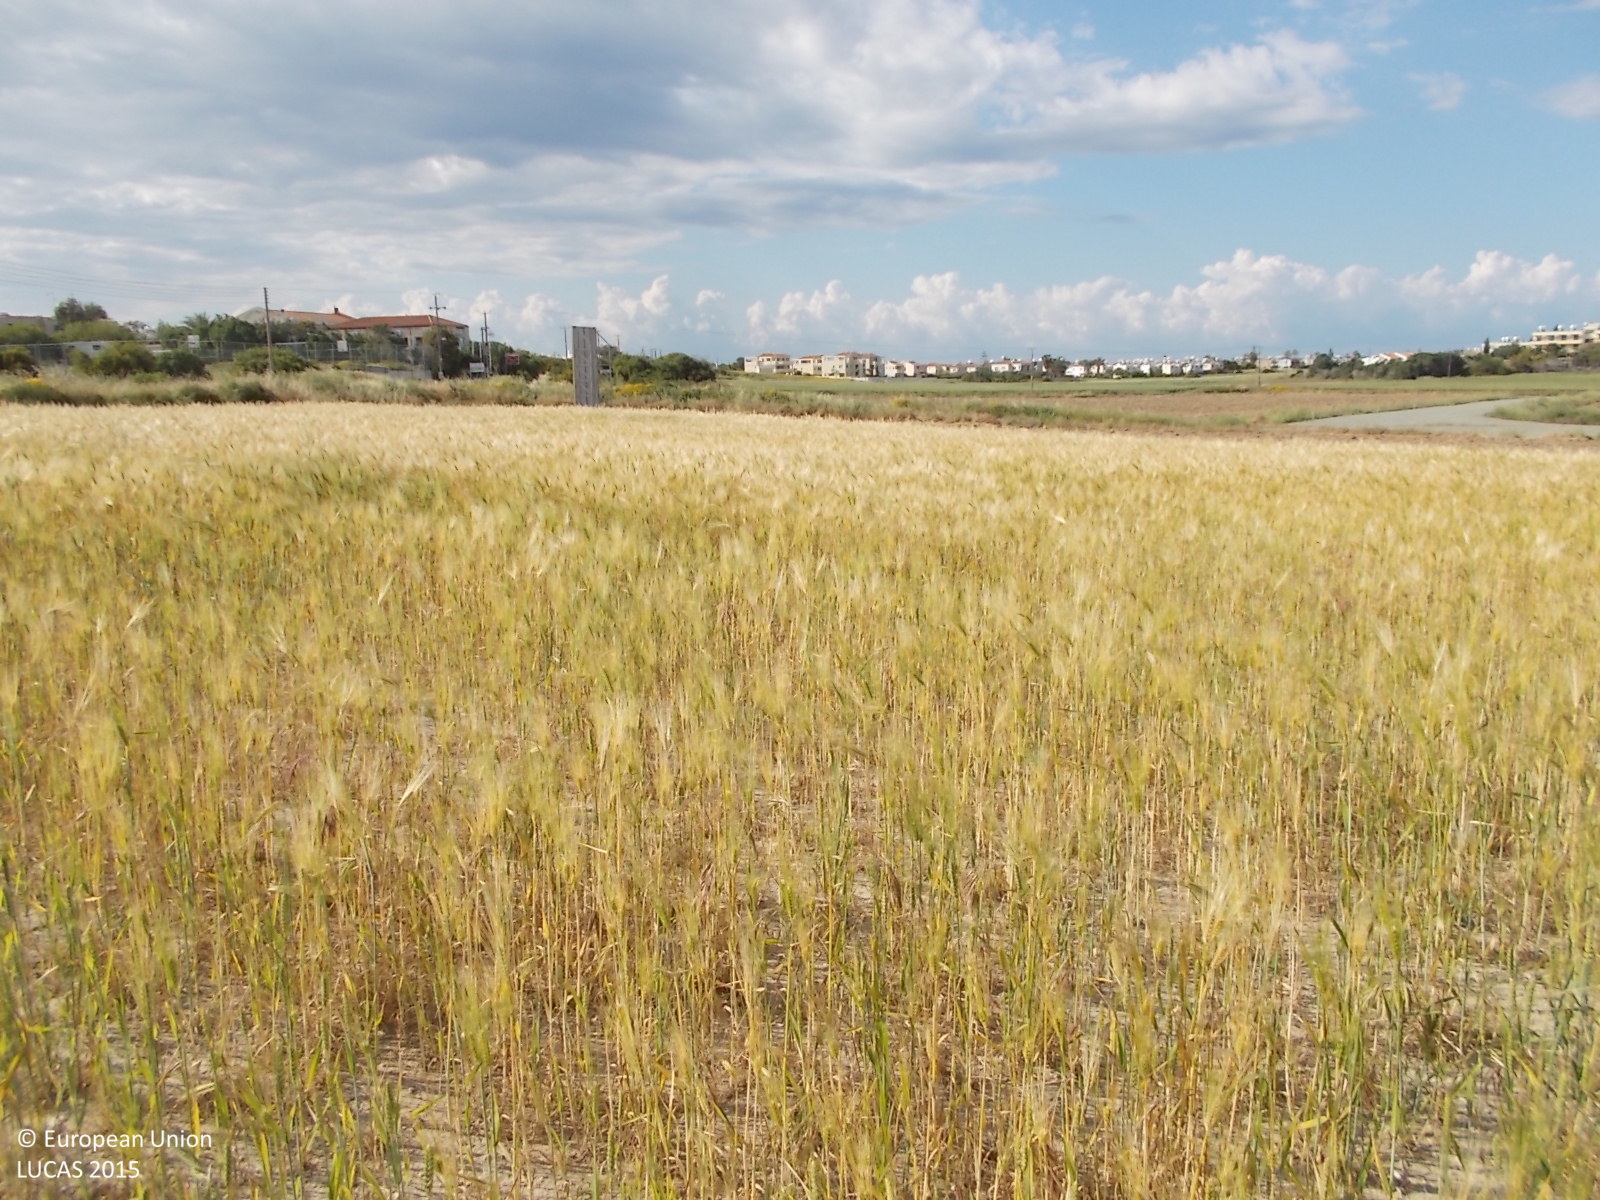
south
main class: Cropland
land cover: Barley
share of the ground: > 75 %
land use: Agriculture (excluding fallow land and kitchen gardens)
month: April
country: CY
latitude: 34.8259
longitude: 33.6010
